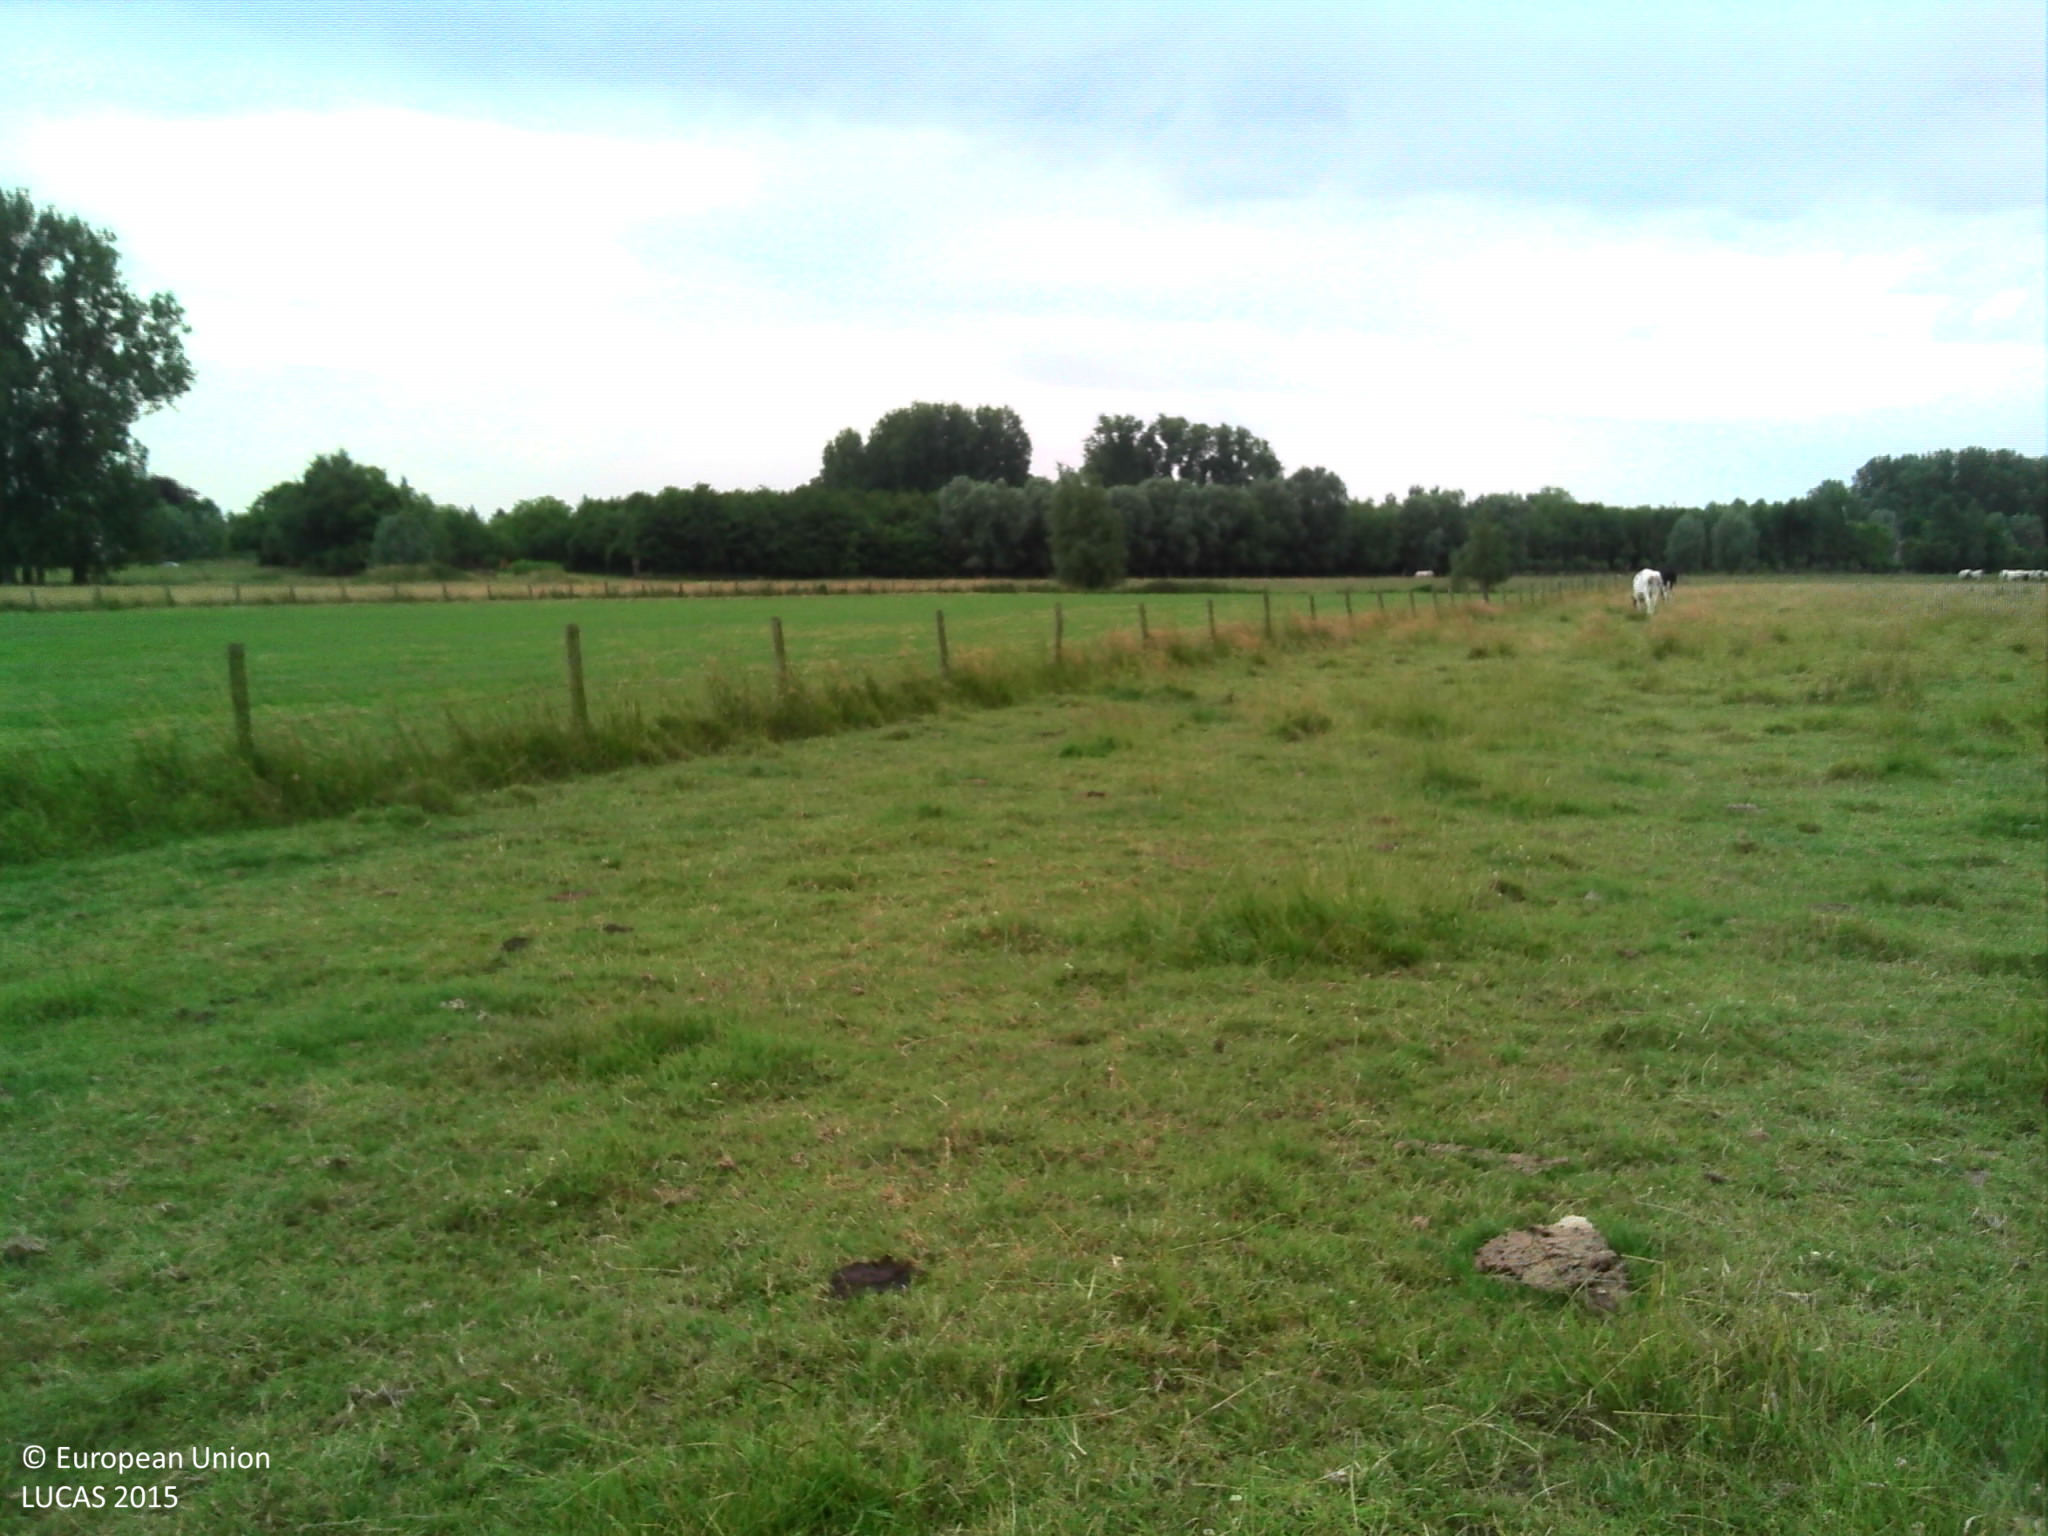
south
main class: Grassland
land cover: Grassland without tree/shrub cover
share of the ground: > 75 %
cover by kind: herbaceous plants 100 %
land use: Agriculture (excluding fallow land and kitchen gardens)
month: June
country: BE
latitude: 50.9946
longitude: 3.5666
